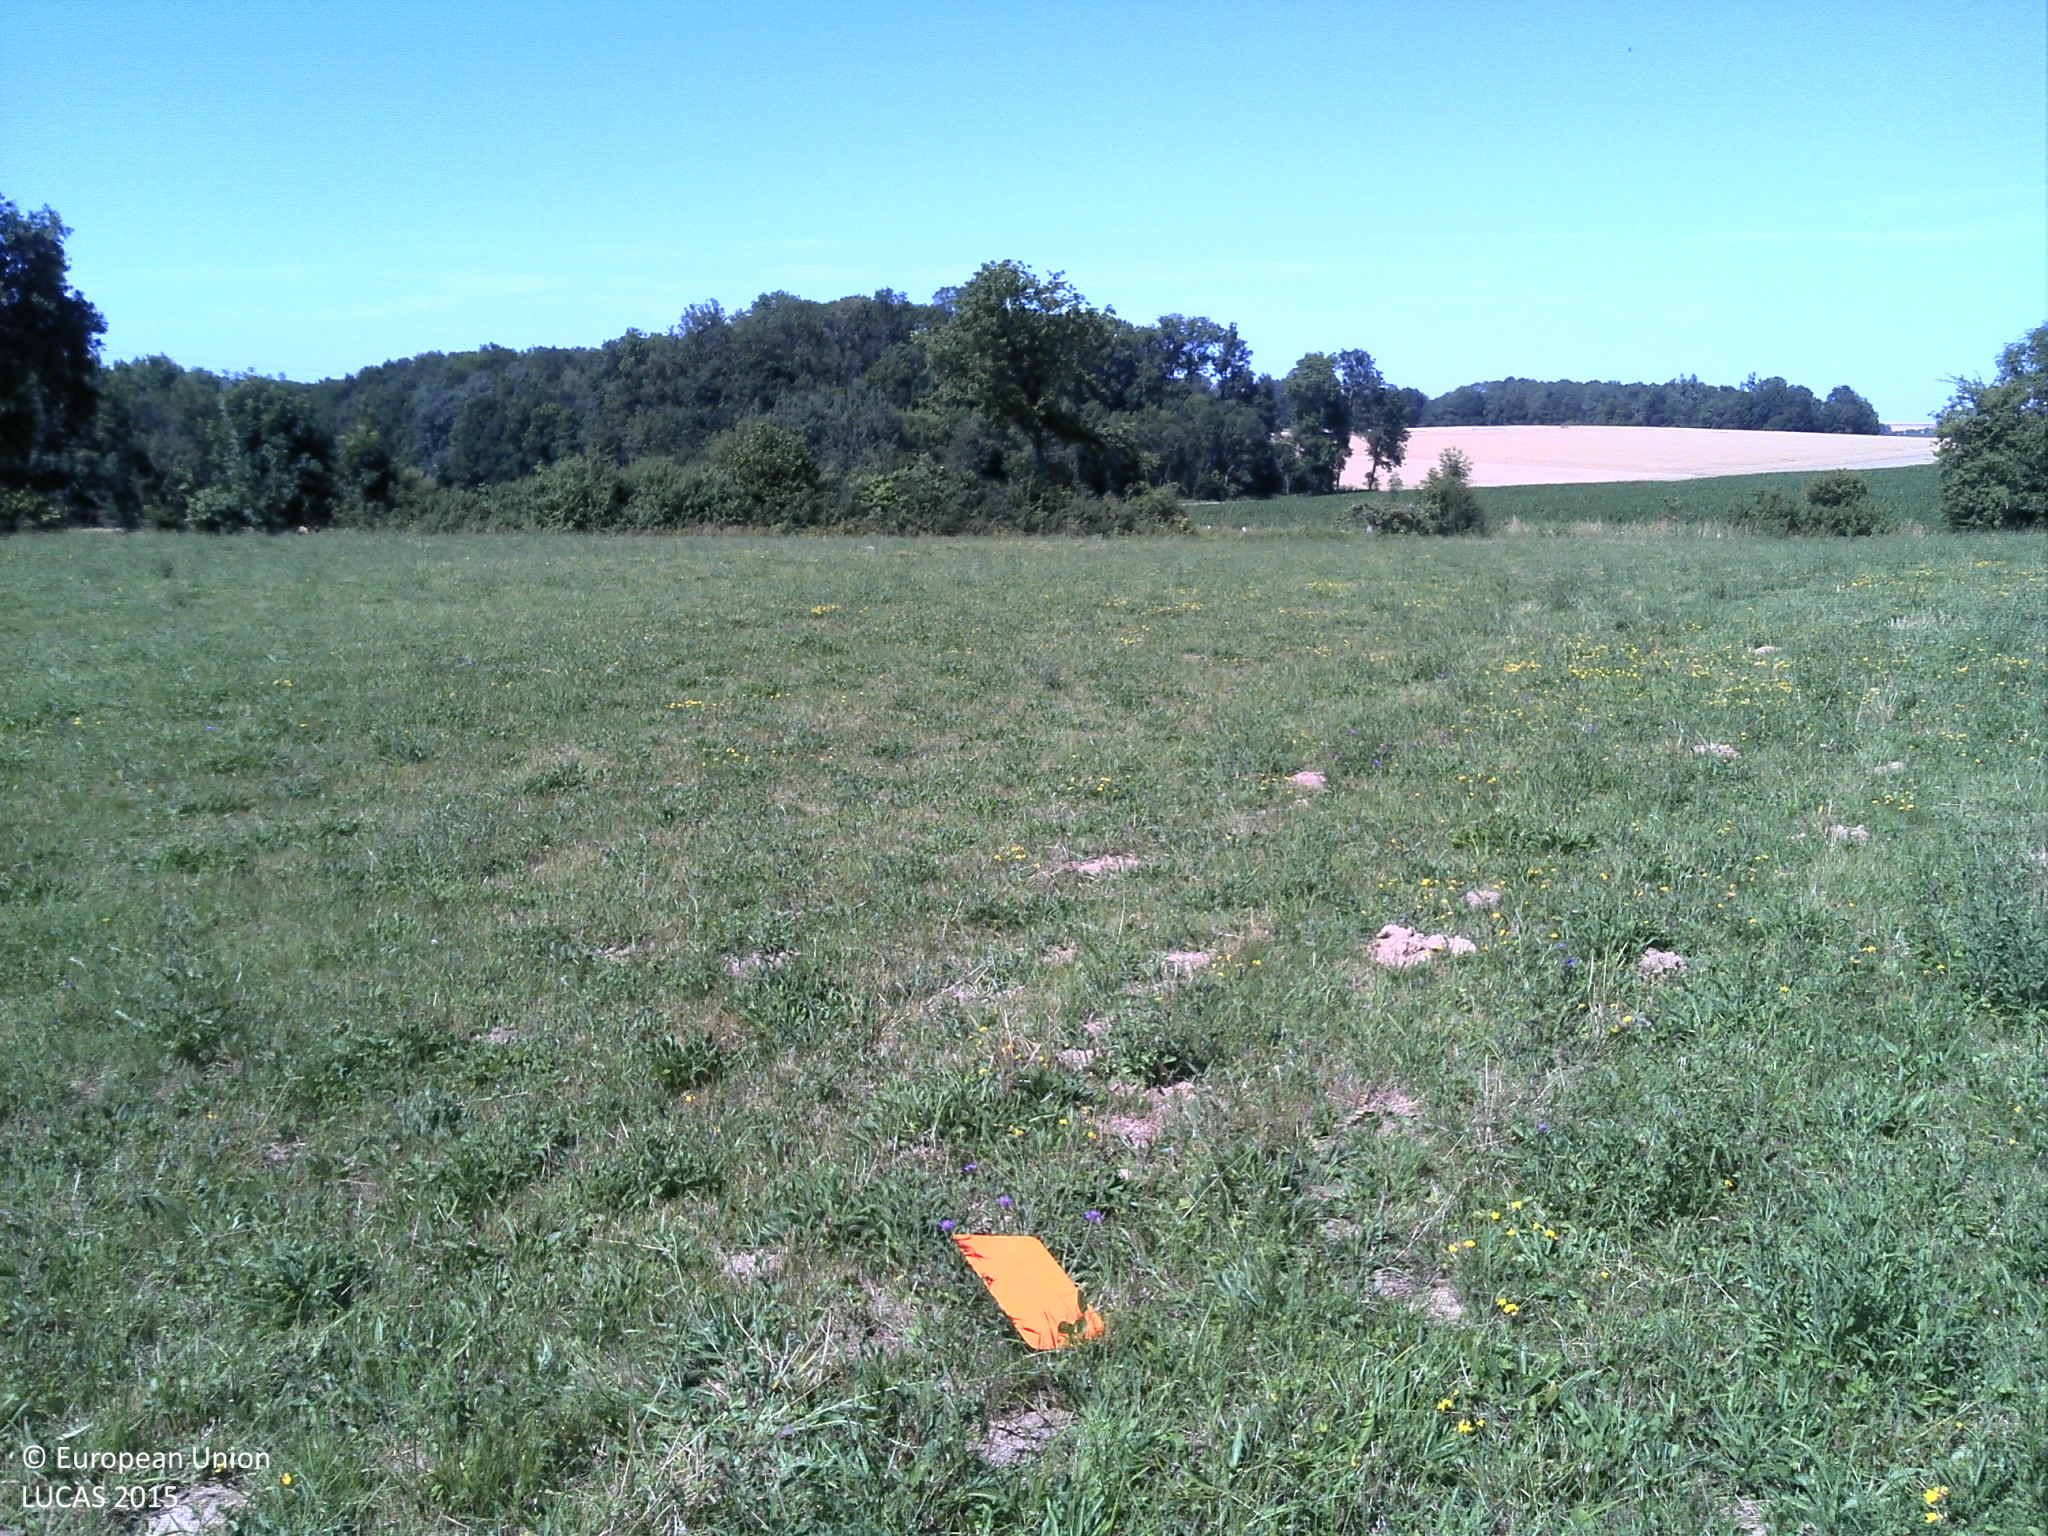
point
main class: Grassland
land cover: Grassland without tree/shrub cover
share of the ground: > 75 %
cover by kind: herbaceous plants 100 %
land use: Agriculture (excluding fallow land and kitchen gardens)
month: July
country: FR
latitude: 49.5040
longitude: 4.7356
